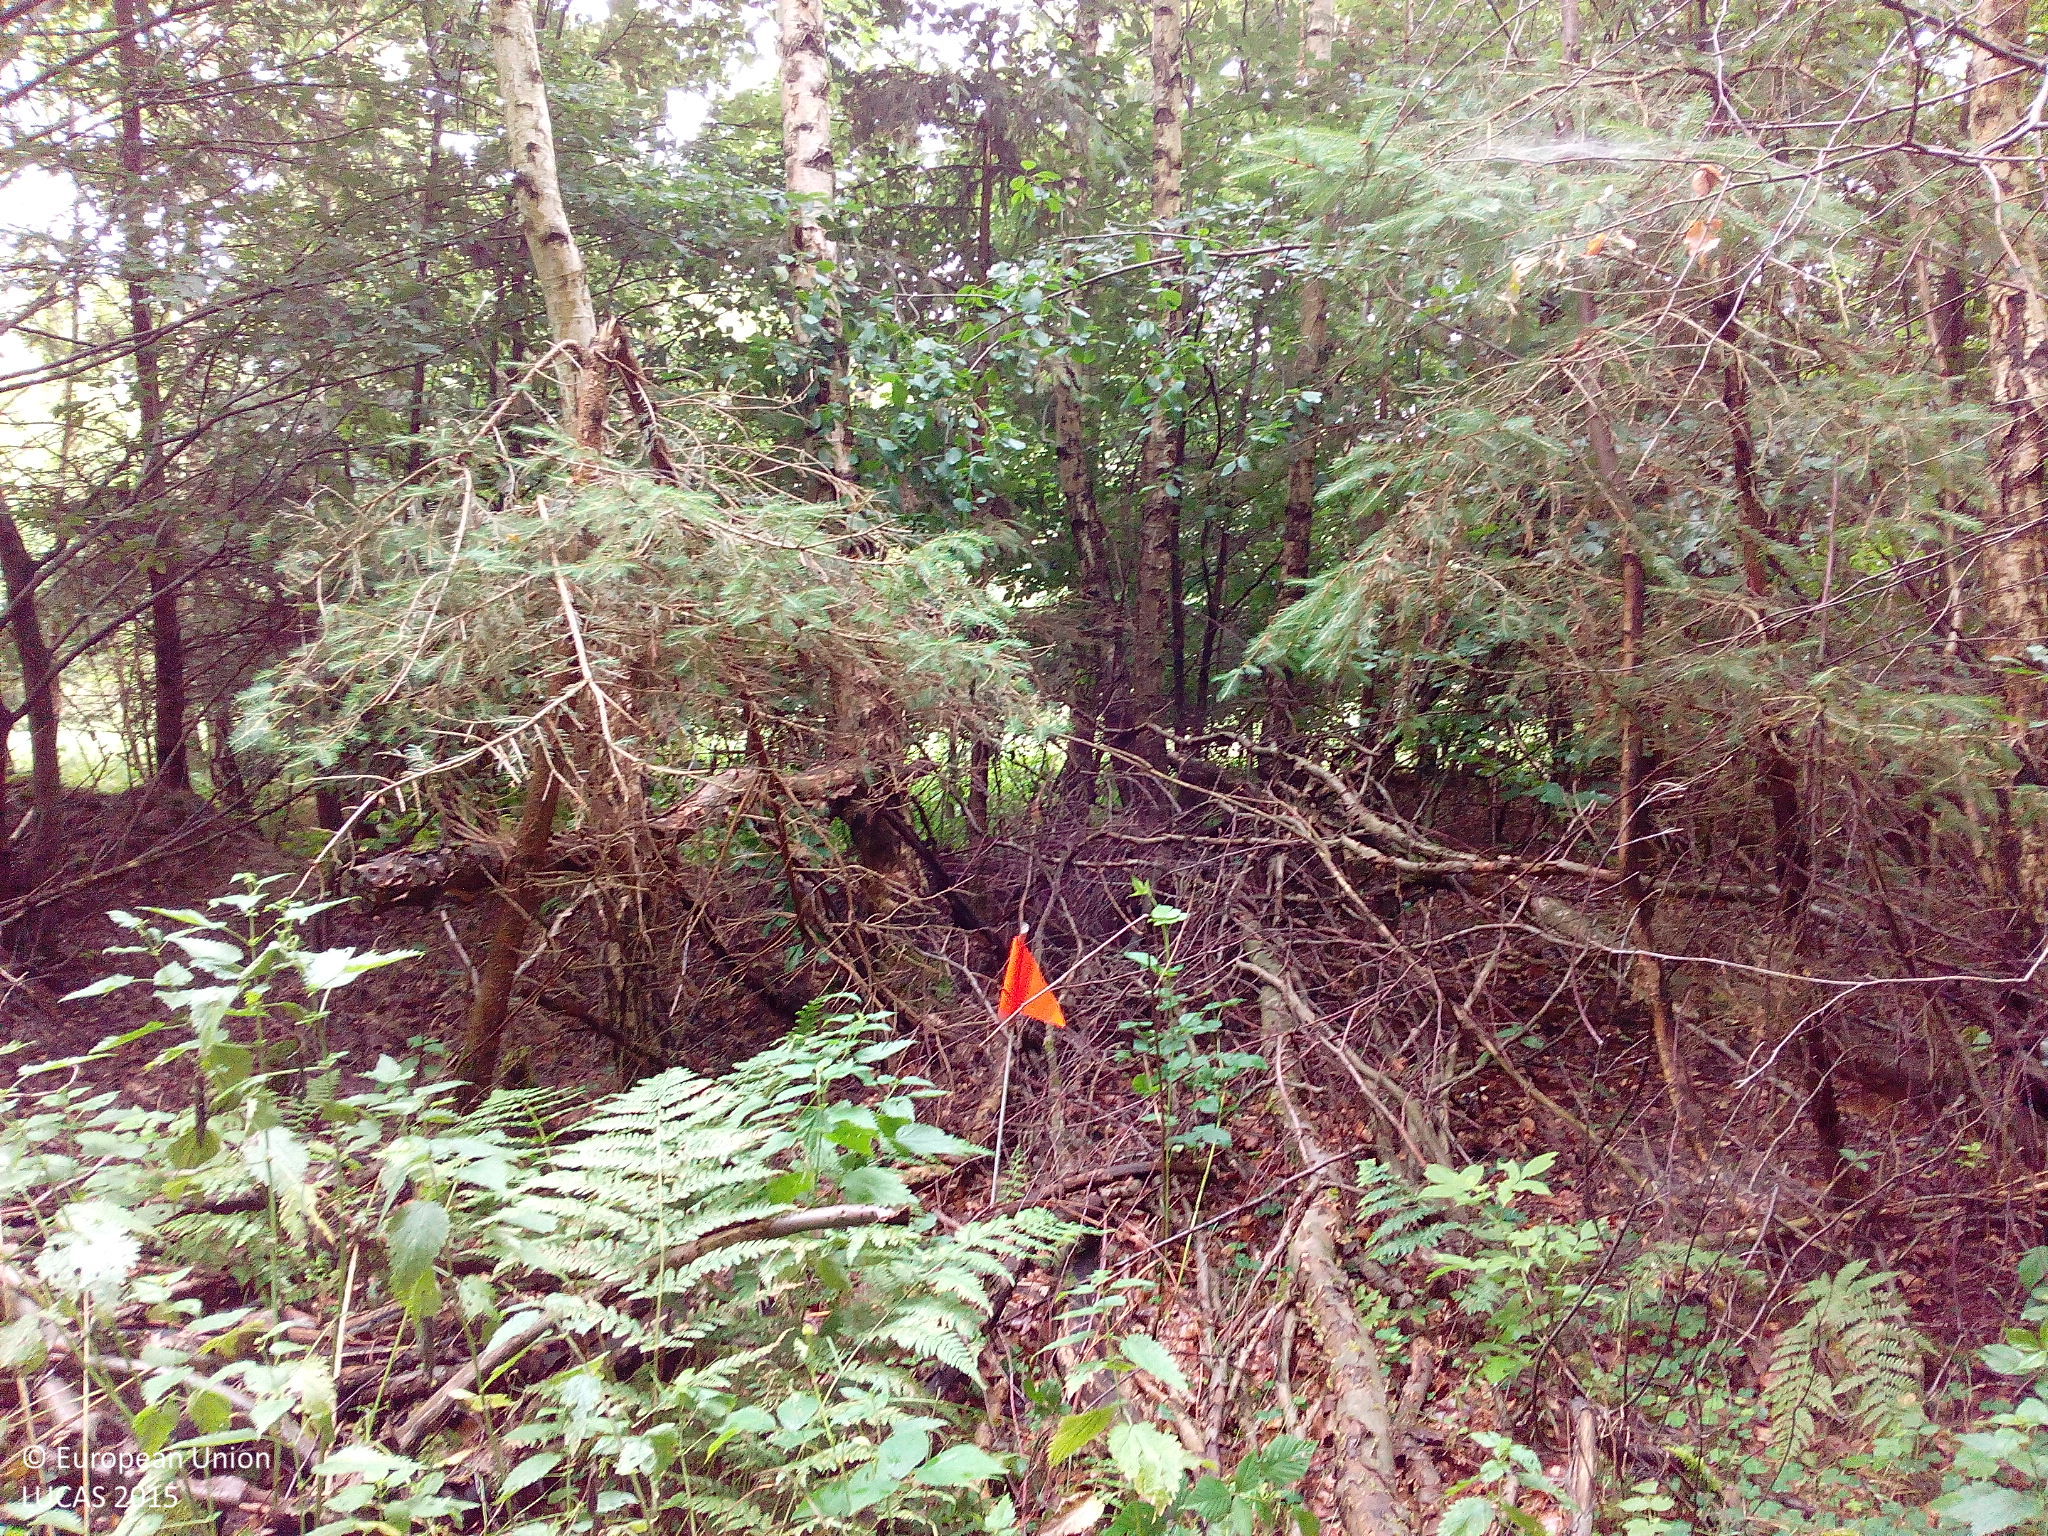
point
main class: Woodland
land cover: Spruce dominated mixed woodland
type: hemiboreal forest and nemoral coniferous forest and mixed broadleaved-coniferous forest
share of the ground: > 75 %
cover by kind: broadleaved forest trees 65 %, coniferous forest trees 25 %, herbaceous plants 10 %
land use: Forestry
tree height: > 5 m
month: July
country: DE
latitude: 50.8674
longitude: 9.9290
